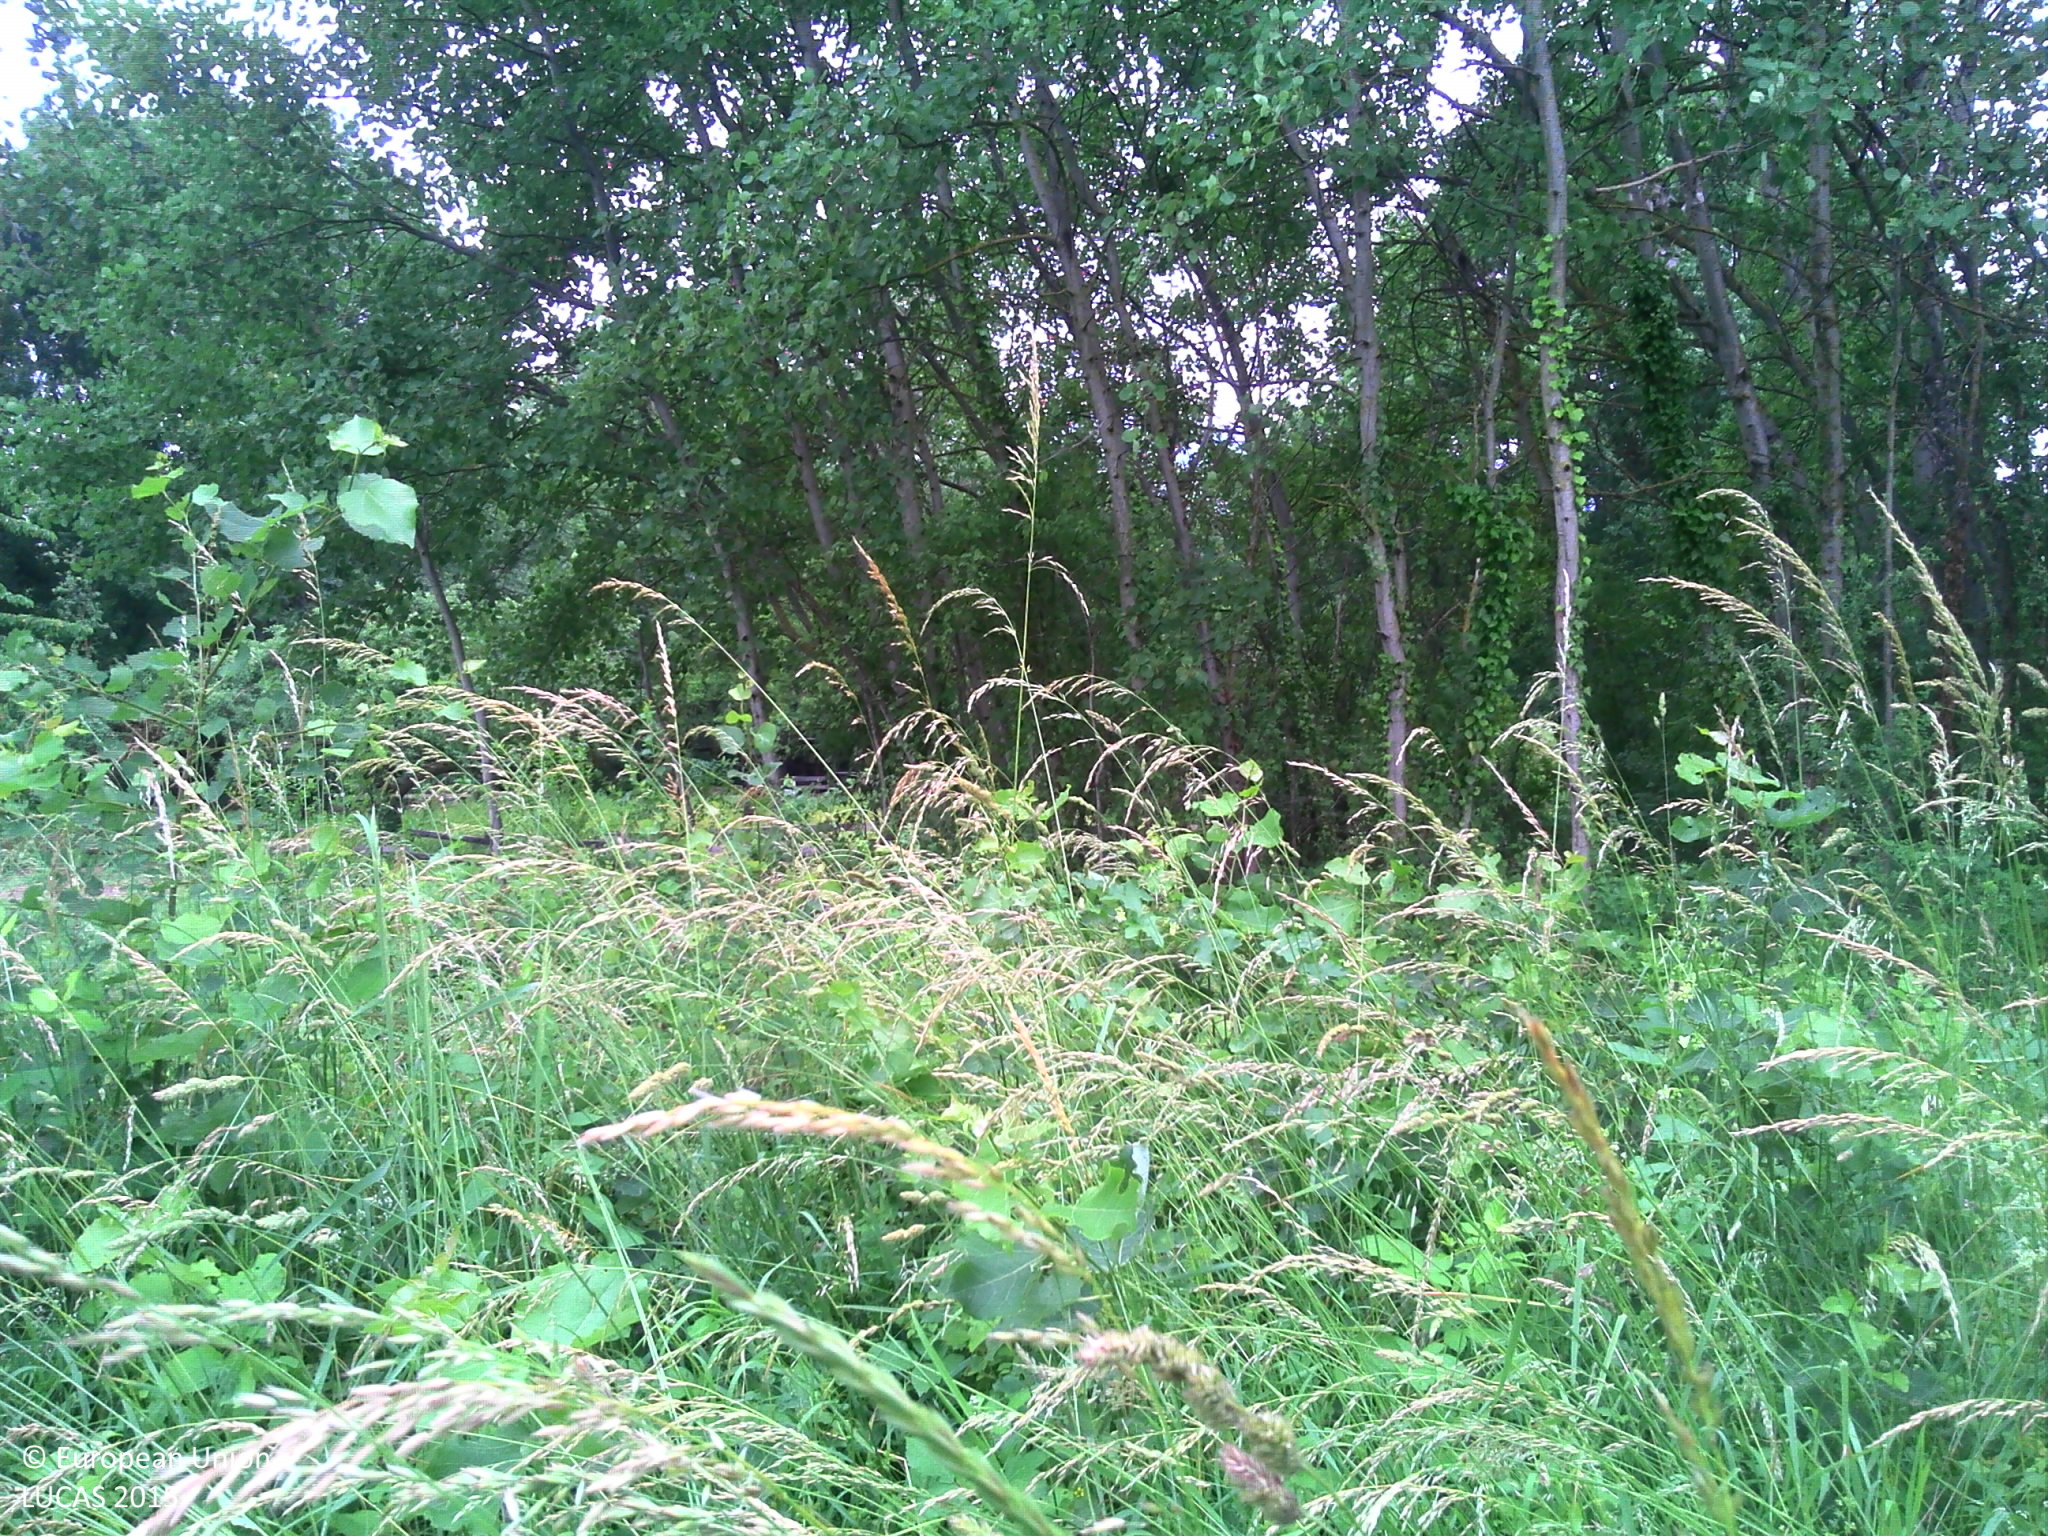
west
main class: Grassland
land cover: Spontaneously vegetated surfaces
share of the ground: > 75 %
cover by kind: herbaceous plants 95 %, shrubs 5 %
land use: Semi-natural and natural areas not in use
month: June
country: FR
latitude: 48.4466
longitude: 7.4727
